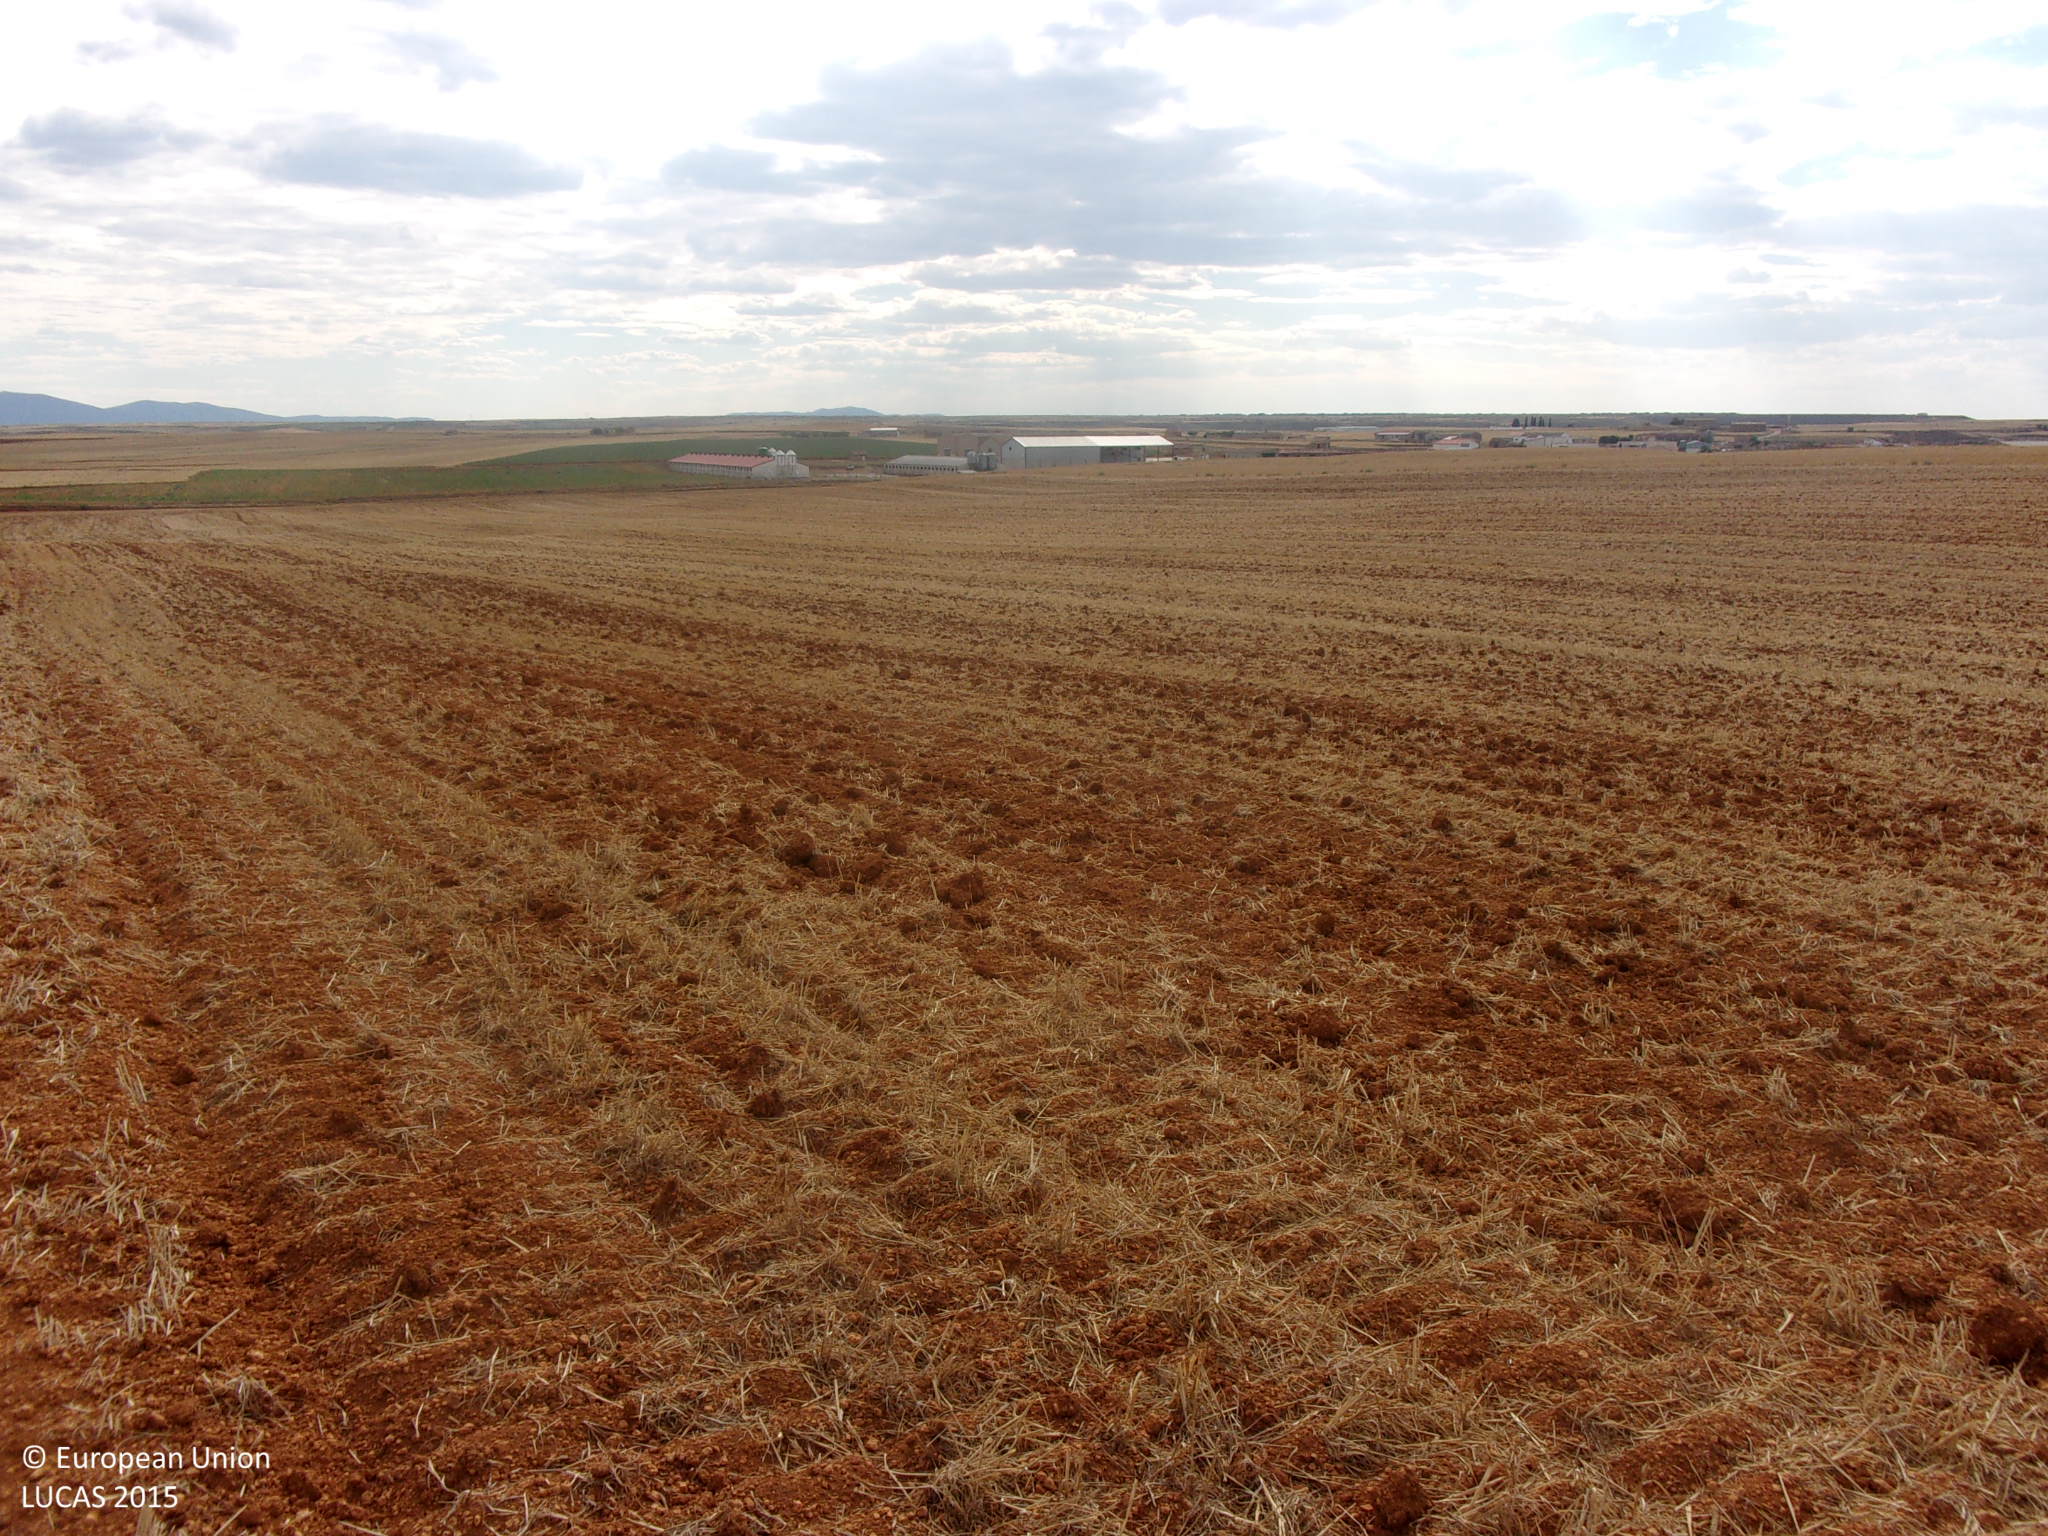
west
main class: Cropland
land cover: Barley
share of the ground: < 10 %
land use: Agriculture (excluding fallow land and kitchen gardens)
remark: Harvested field
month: July
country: ES
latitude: 41.2077
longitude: -1.3871
